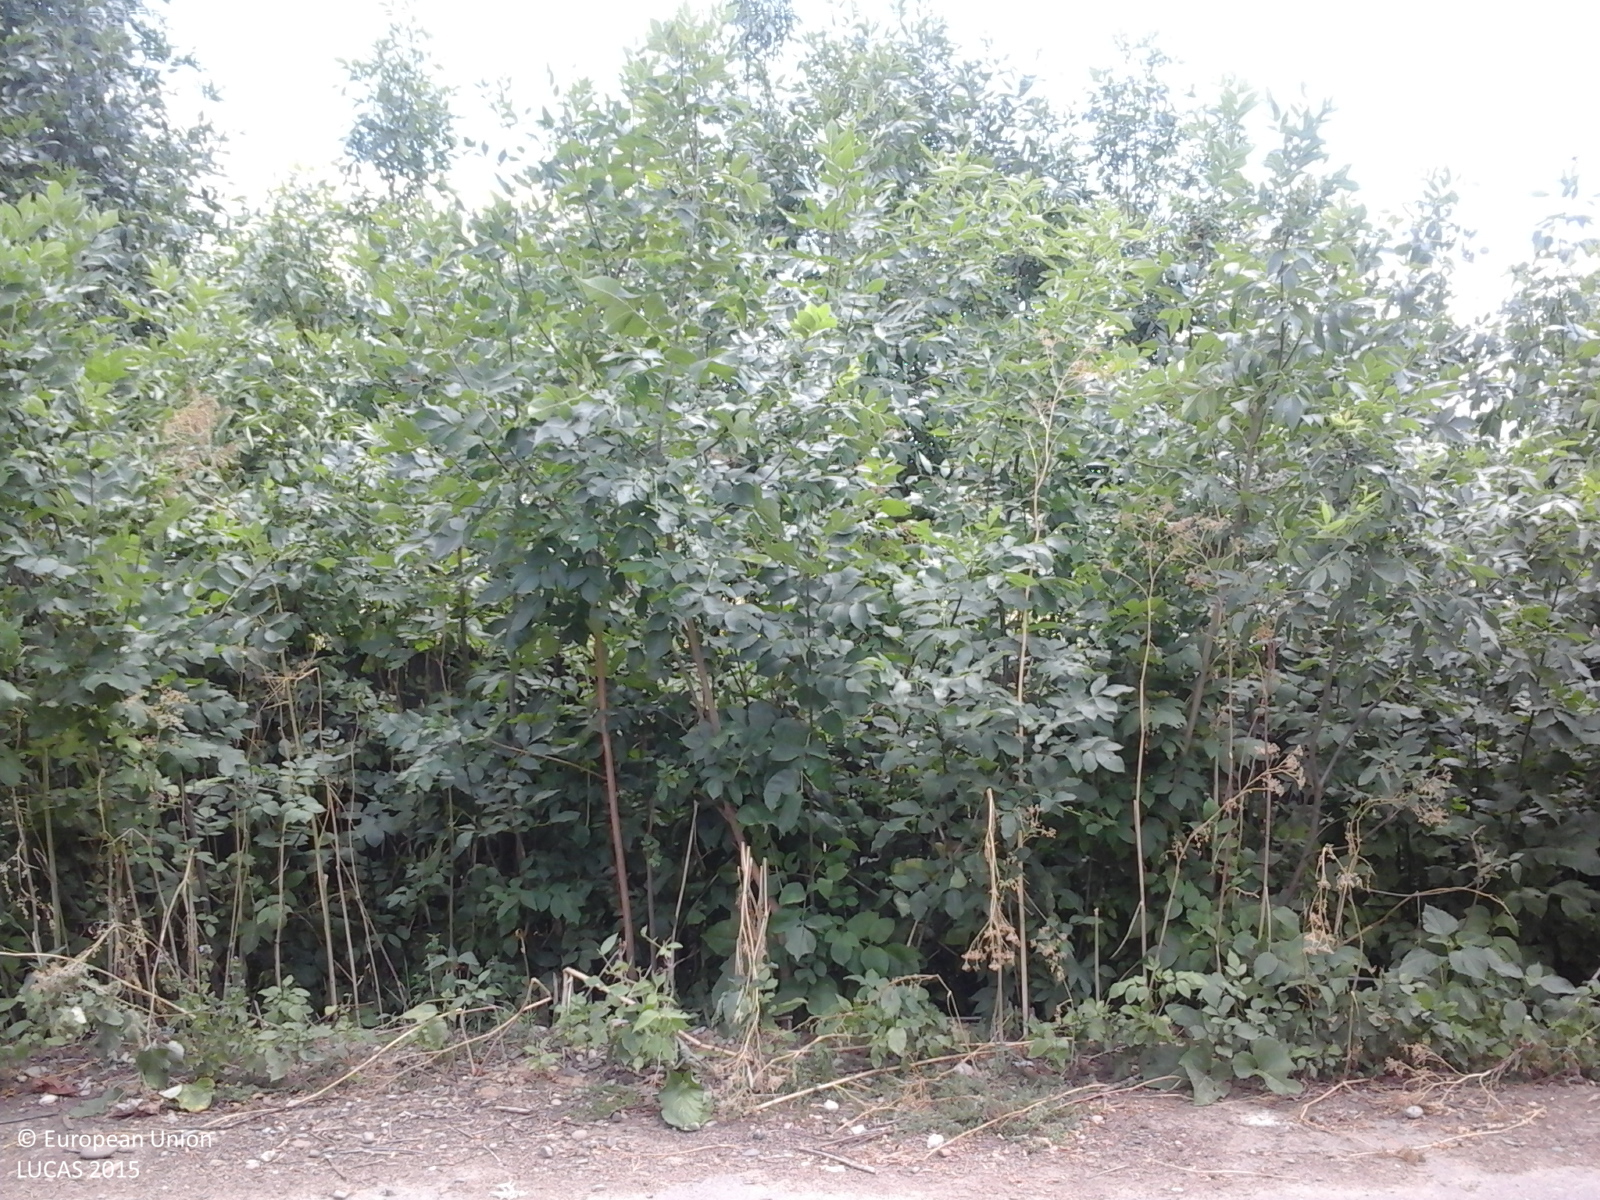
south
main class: Cropland
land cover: Maize
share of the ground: > 75 %
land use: Agriculture (excluding fallow land and kitchen gardens)
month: July
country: RO
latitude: 46.1950
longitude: 27.5380
